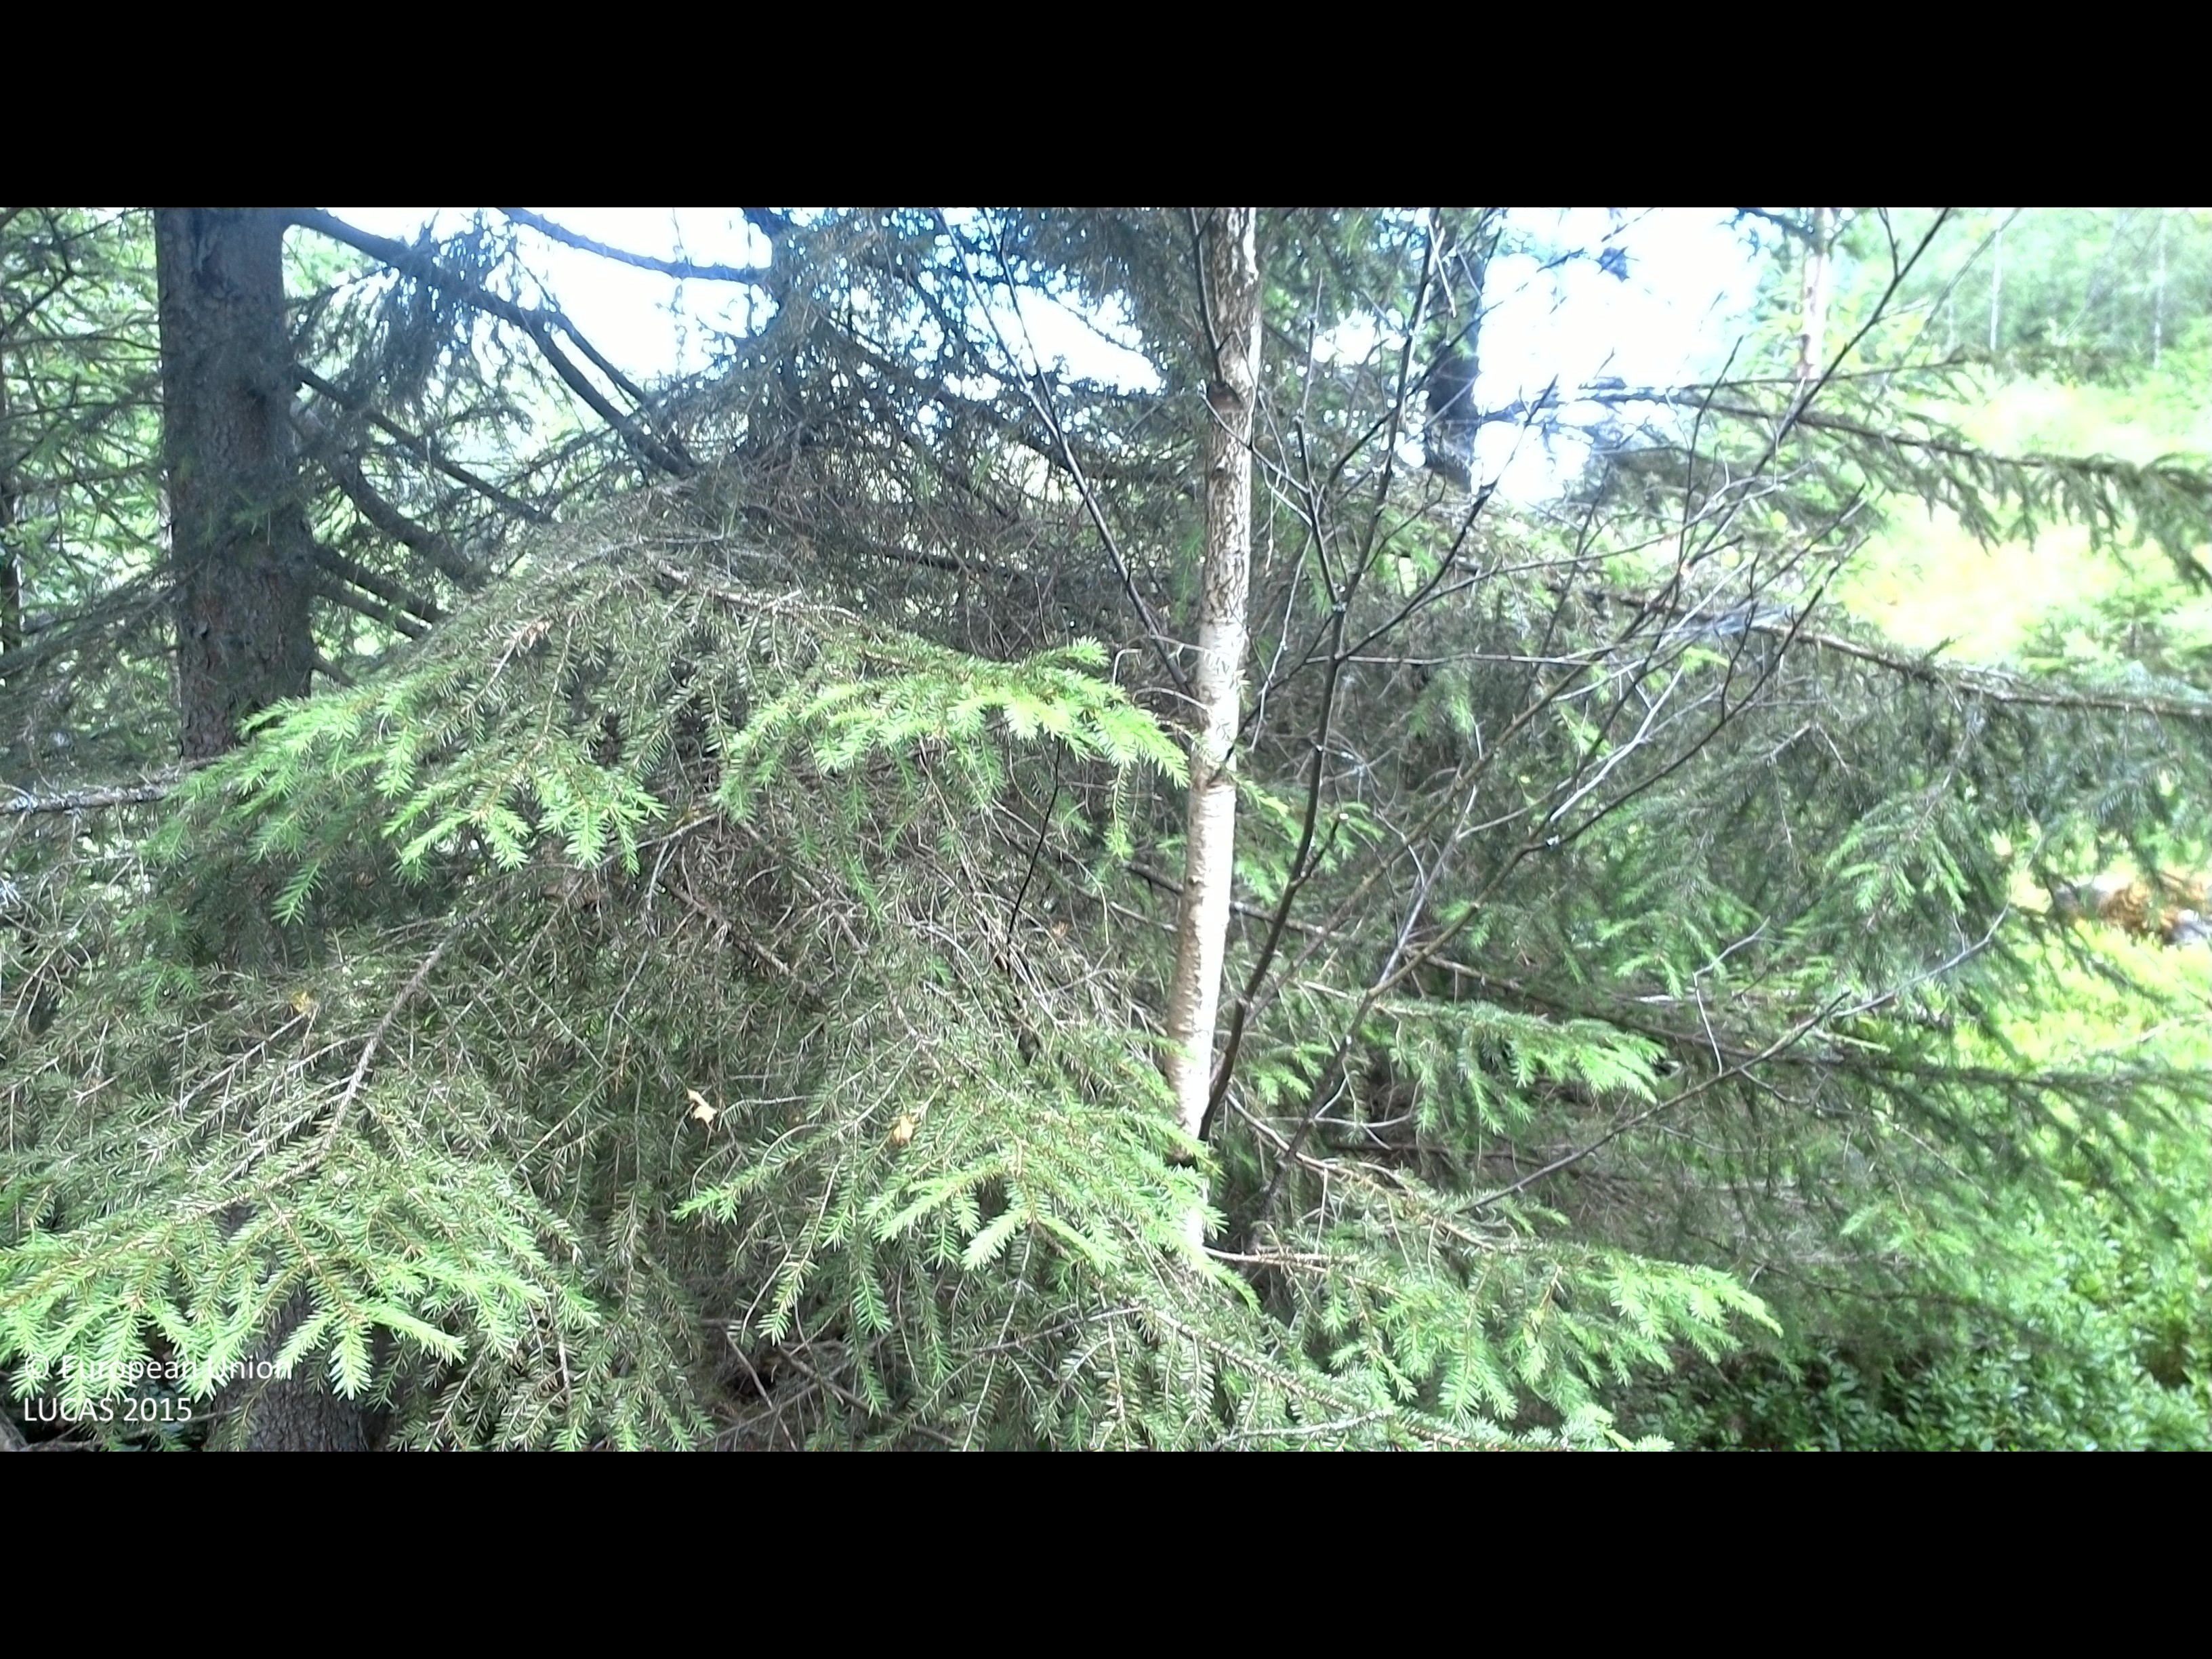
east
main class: Woodland
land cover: Spruce dominated coniferous woodland
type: boreal forest
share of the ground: > 75 %
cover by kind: coniferous forest trees 75 %, shrubs 10 %, broadleaved forest trees 5 %, herbaceous plants 5 %, lichens and mosses 5 %
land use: Forestry
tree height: > 5 m
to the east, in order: Spruce dominated coniferous woodland; Pine dominated coniferous woodland; Spruce dominated mixed woodland; Broadleaved woodland; Spruce dominated mixed woodland
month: July
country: SE
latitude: 56.3543
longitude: 15.1611
